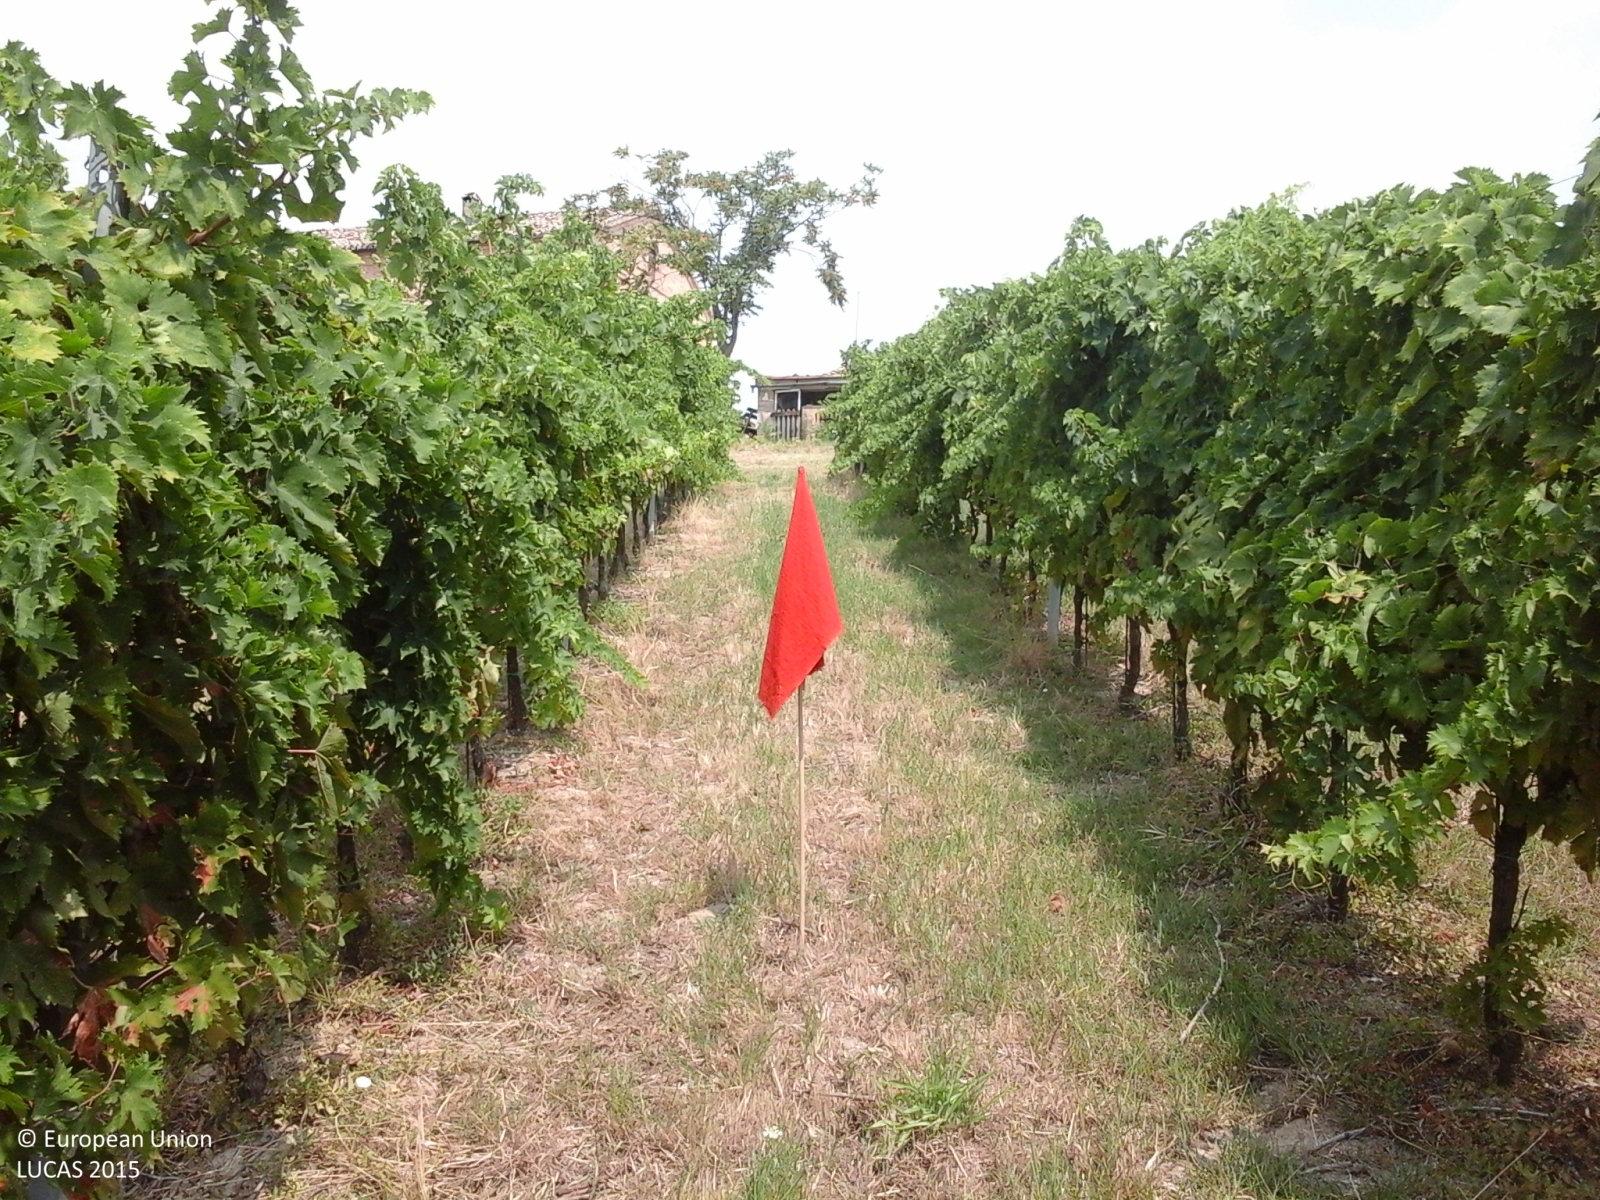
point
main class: Cropland
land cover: Vineyards
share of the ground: > 75 %
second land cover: Spontaneously vegetated surfaces
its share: 50 - 75 %
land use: Agriculture (excluding fallow land and kitchen gardens)
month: August
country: IT
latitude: 43.4269
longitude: 13.4378
